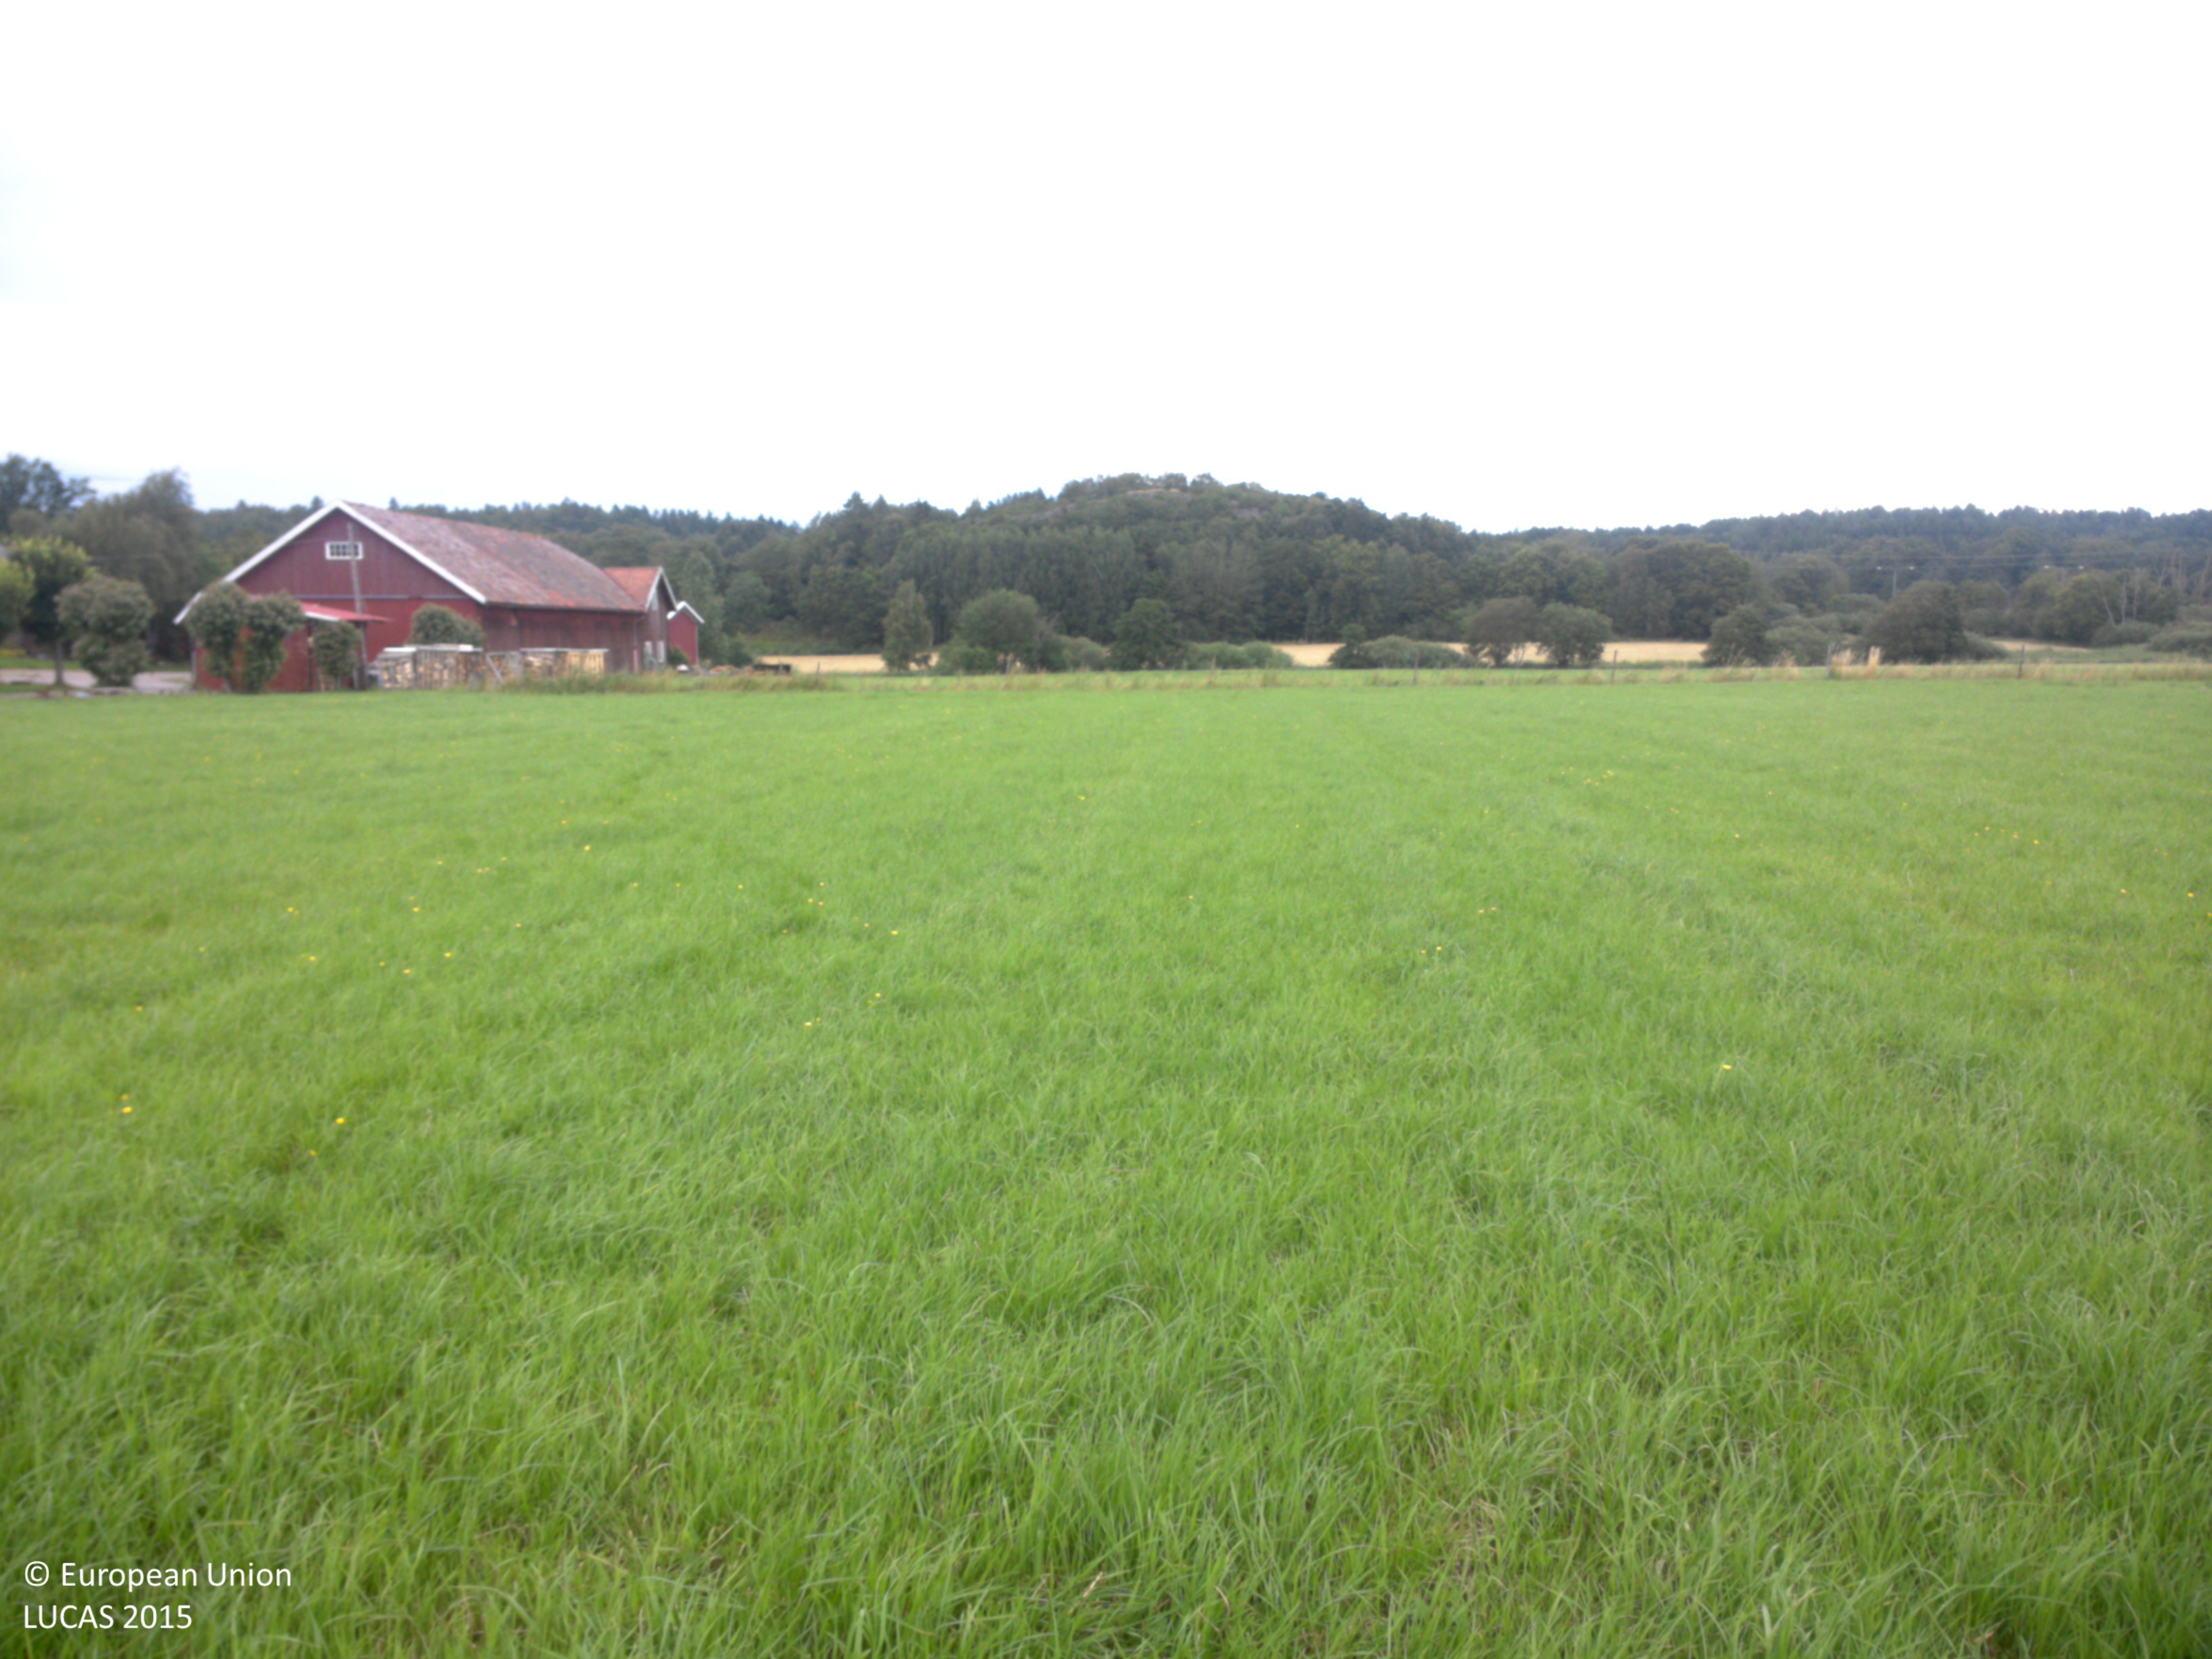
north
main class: Grassland
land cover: Grassland without tree/shrub cover
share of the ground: > 75 %
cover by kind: herbaceous plants 100 %
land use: Agriculture (excluding fallow land and kitchen gardens)
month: July
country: SE
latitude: 58.0270
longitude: 11.8422
